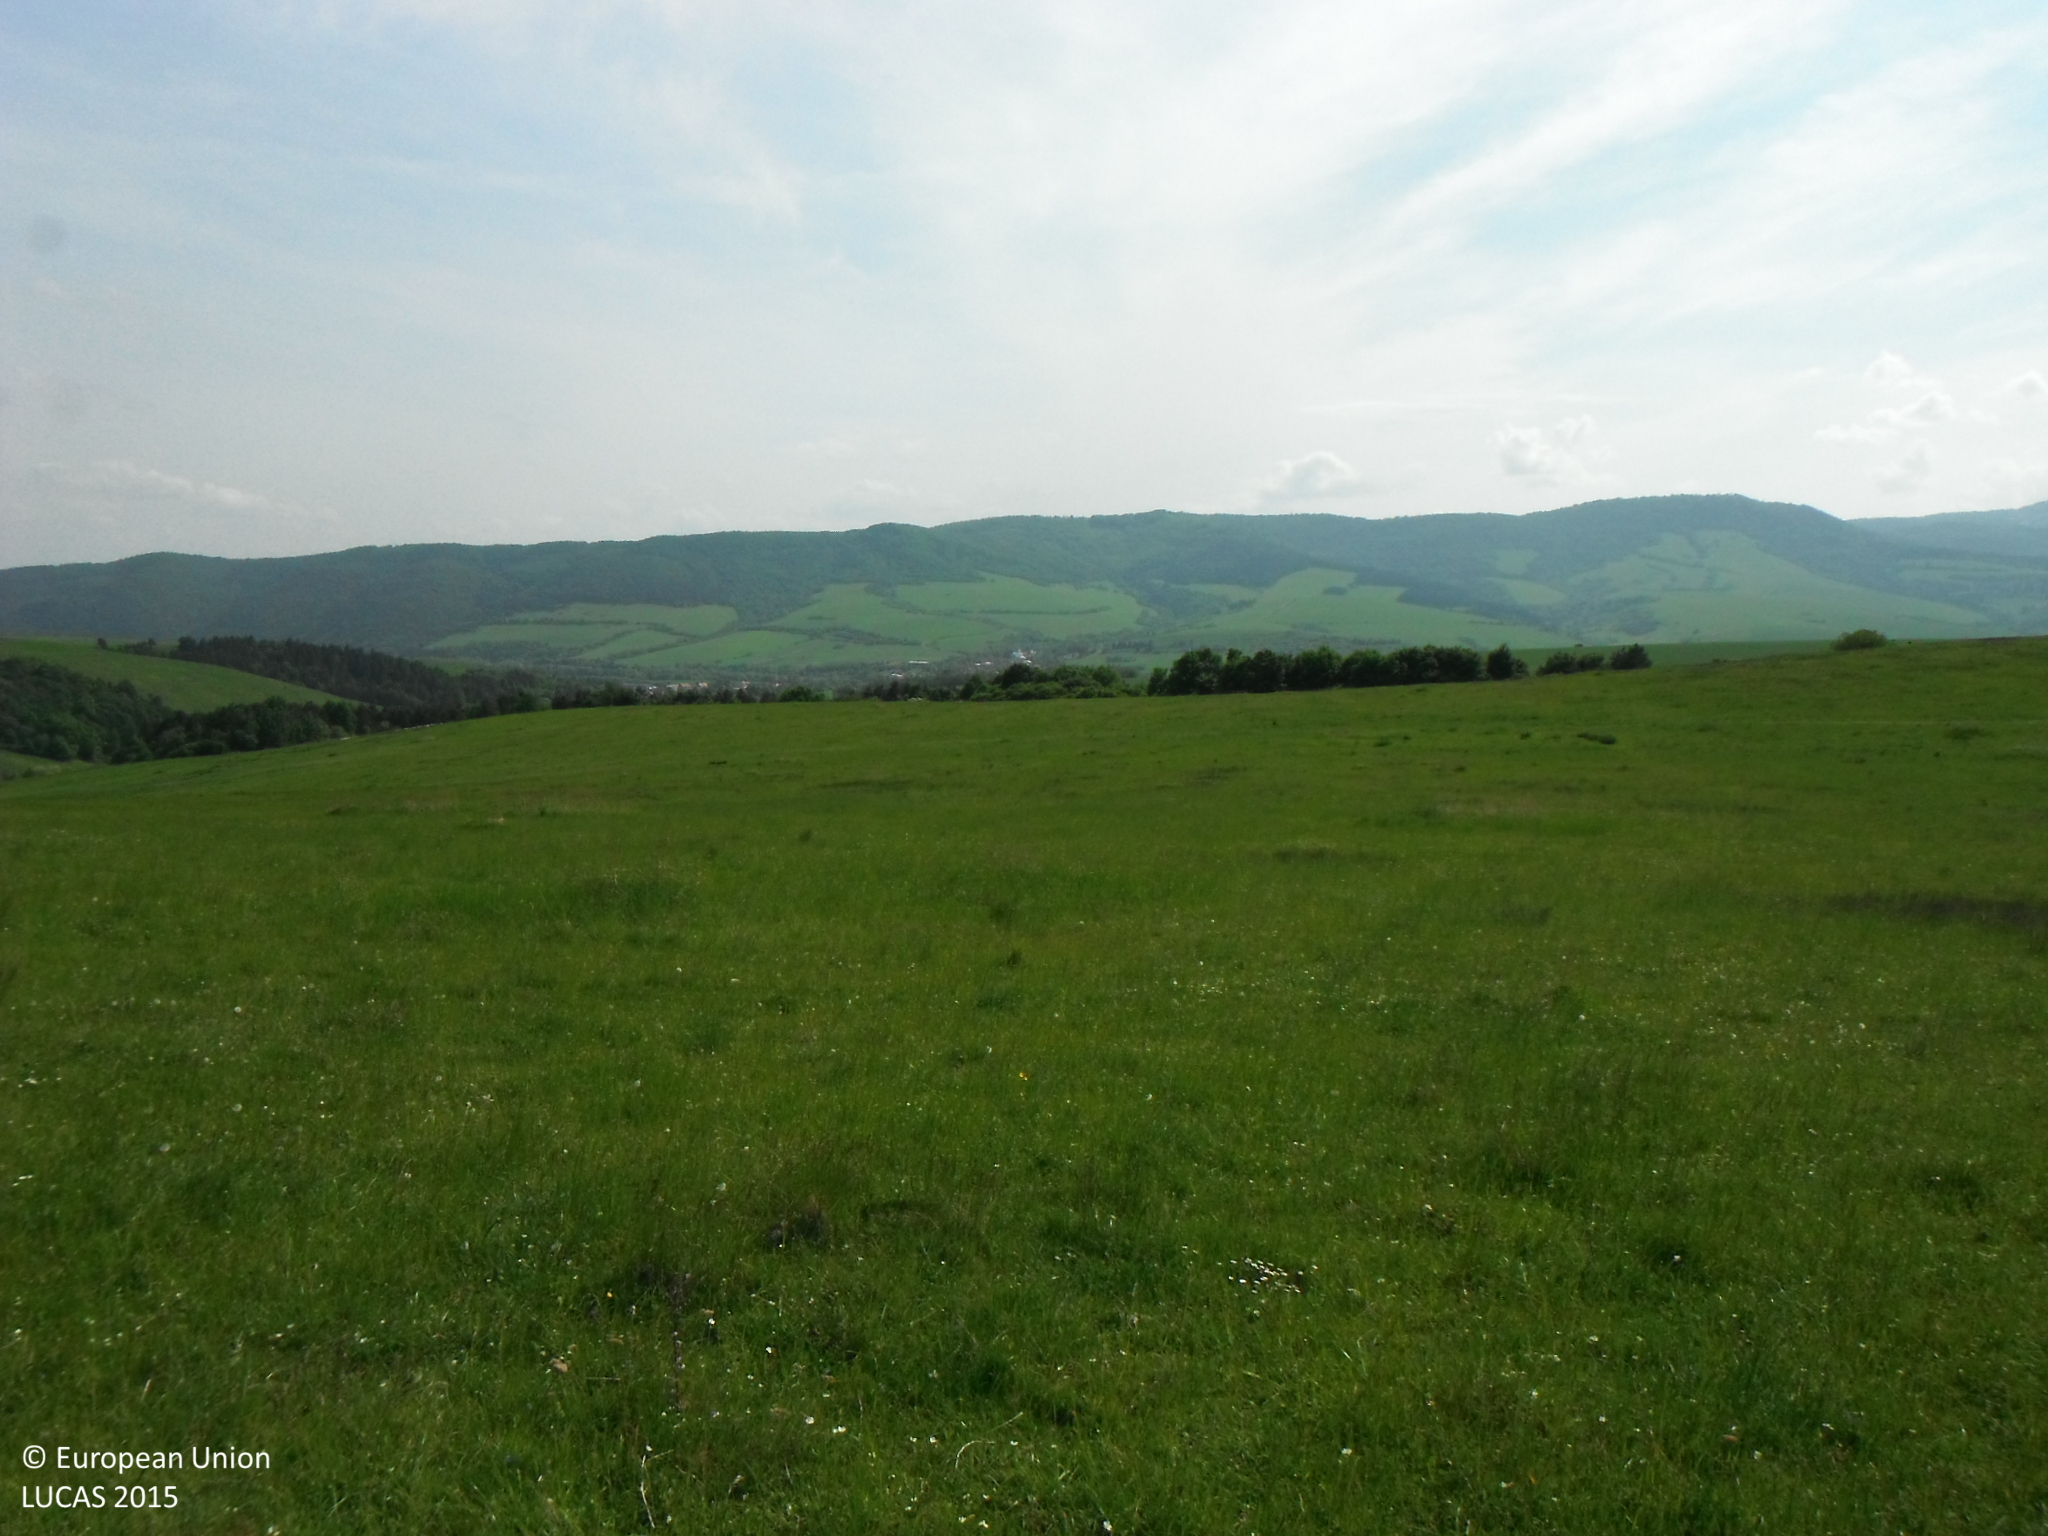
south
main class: Grassland
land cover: Grassland without tree/shrub cover
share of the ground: > 75 %
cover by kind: herbaceous plants 100 %
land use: Agriculture (excluding fallow land and kitchen gardens)
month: May
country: SK
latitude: 49.1575
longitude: 21.0261
